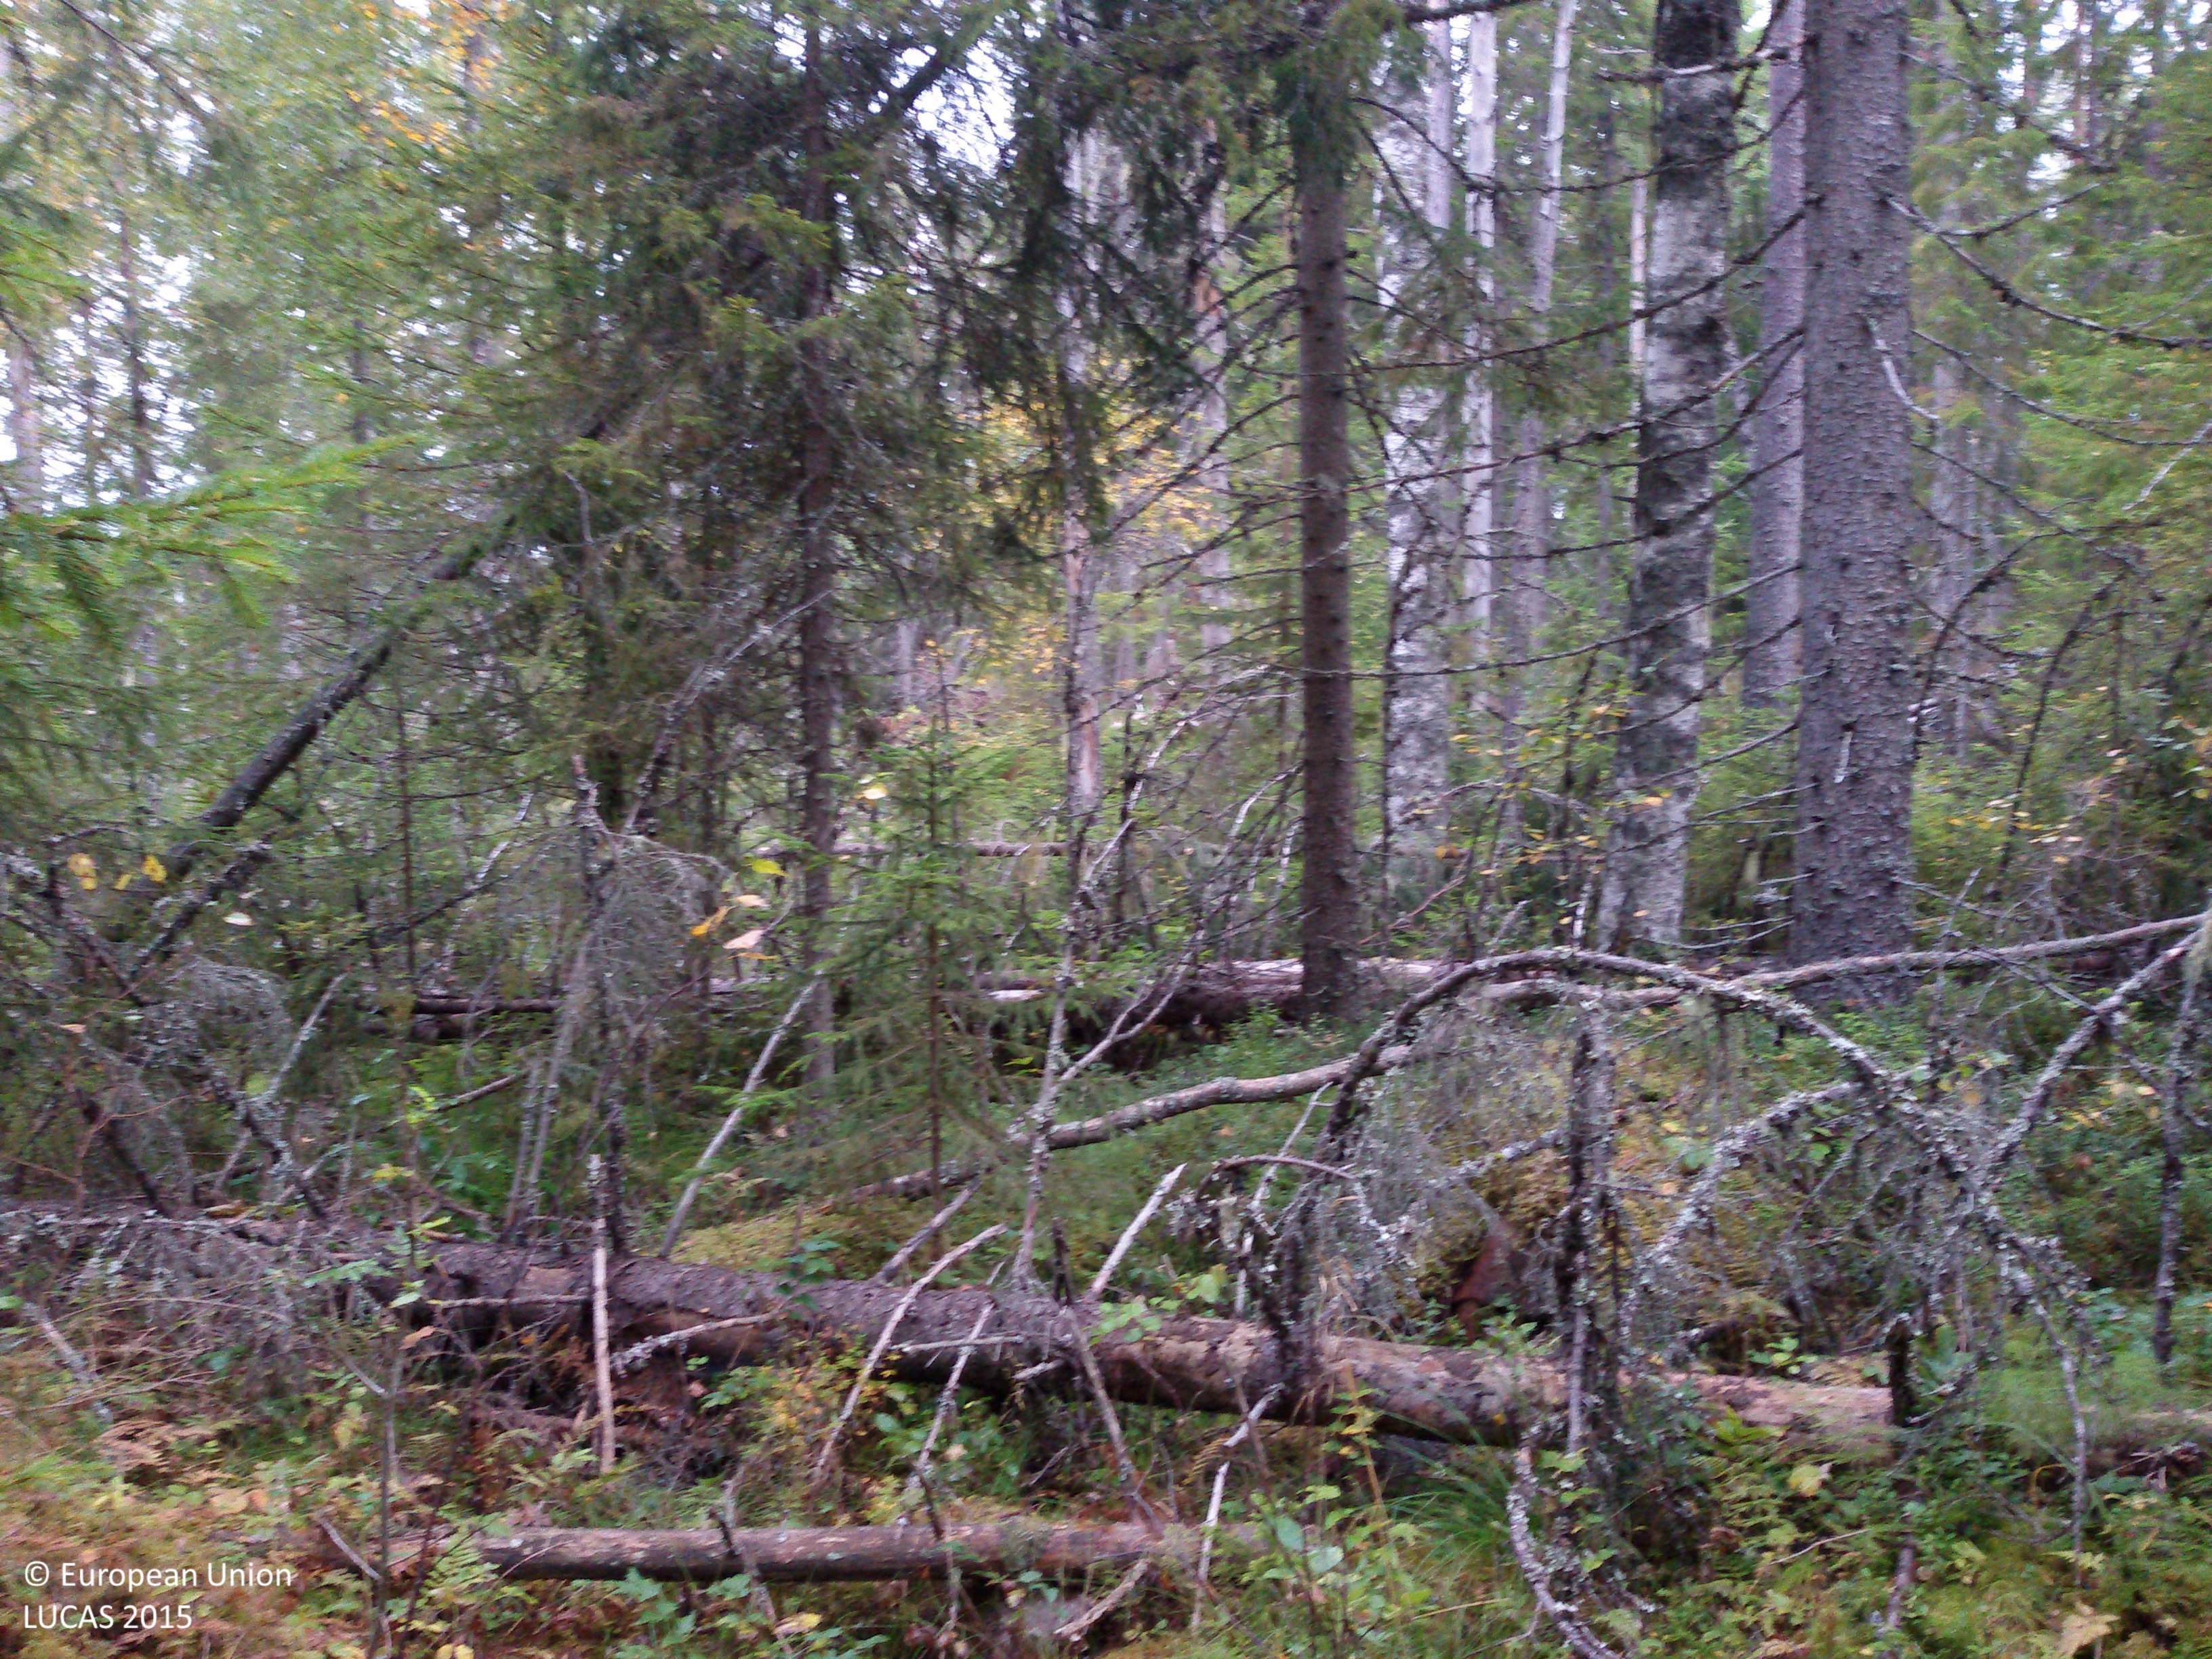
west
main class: Woodland
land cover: Spruce dominated mixed woodland
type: boreal forest
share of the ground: 50 - 75 %
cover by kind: coniferous forest trees 45 %, broadleaved forest trees 25 %, herbaceous plants 15 %, lichens and mosses 15 %
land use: Forestry
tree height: > 5 m
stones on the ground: 10 - 25 %
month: September
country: SE
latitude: 61.0518
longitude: 14.3392
